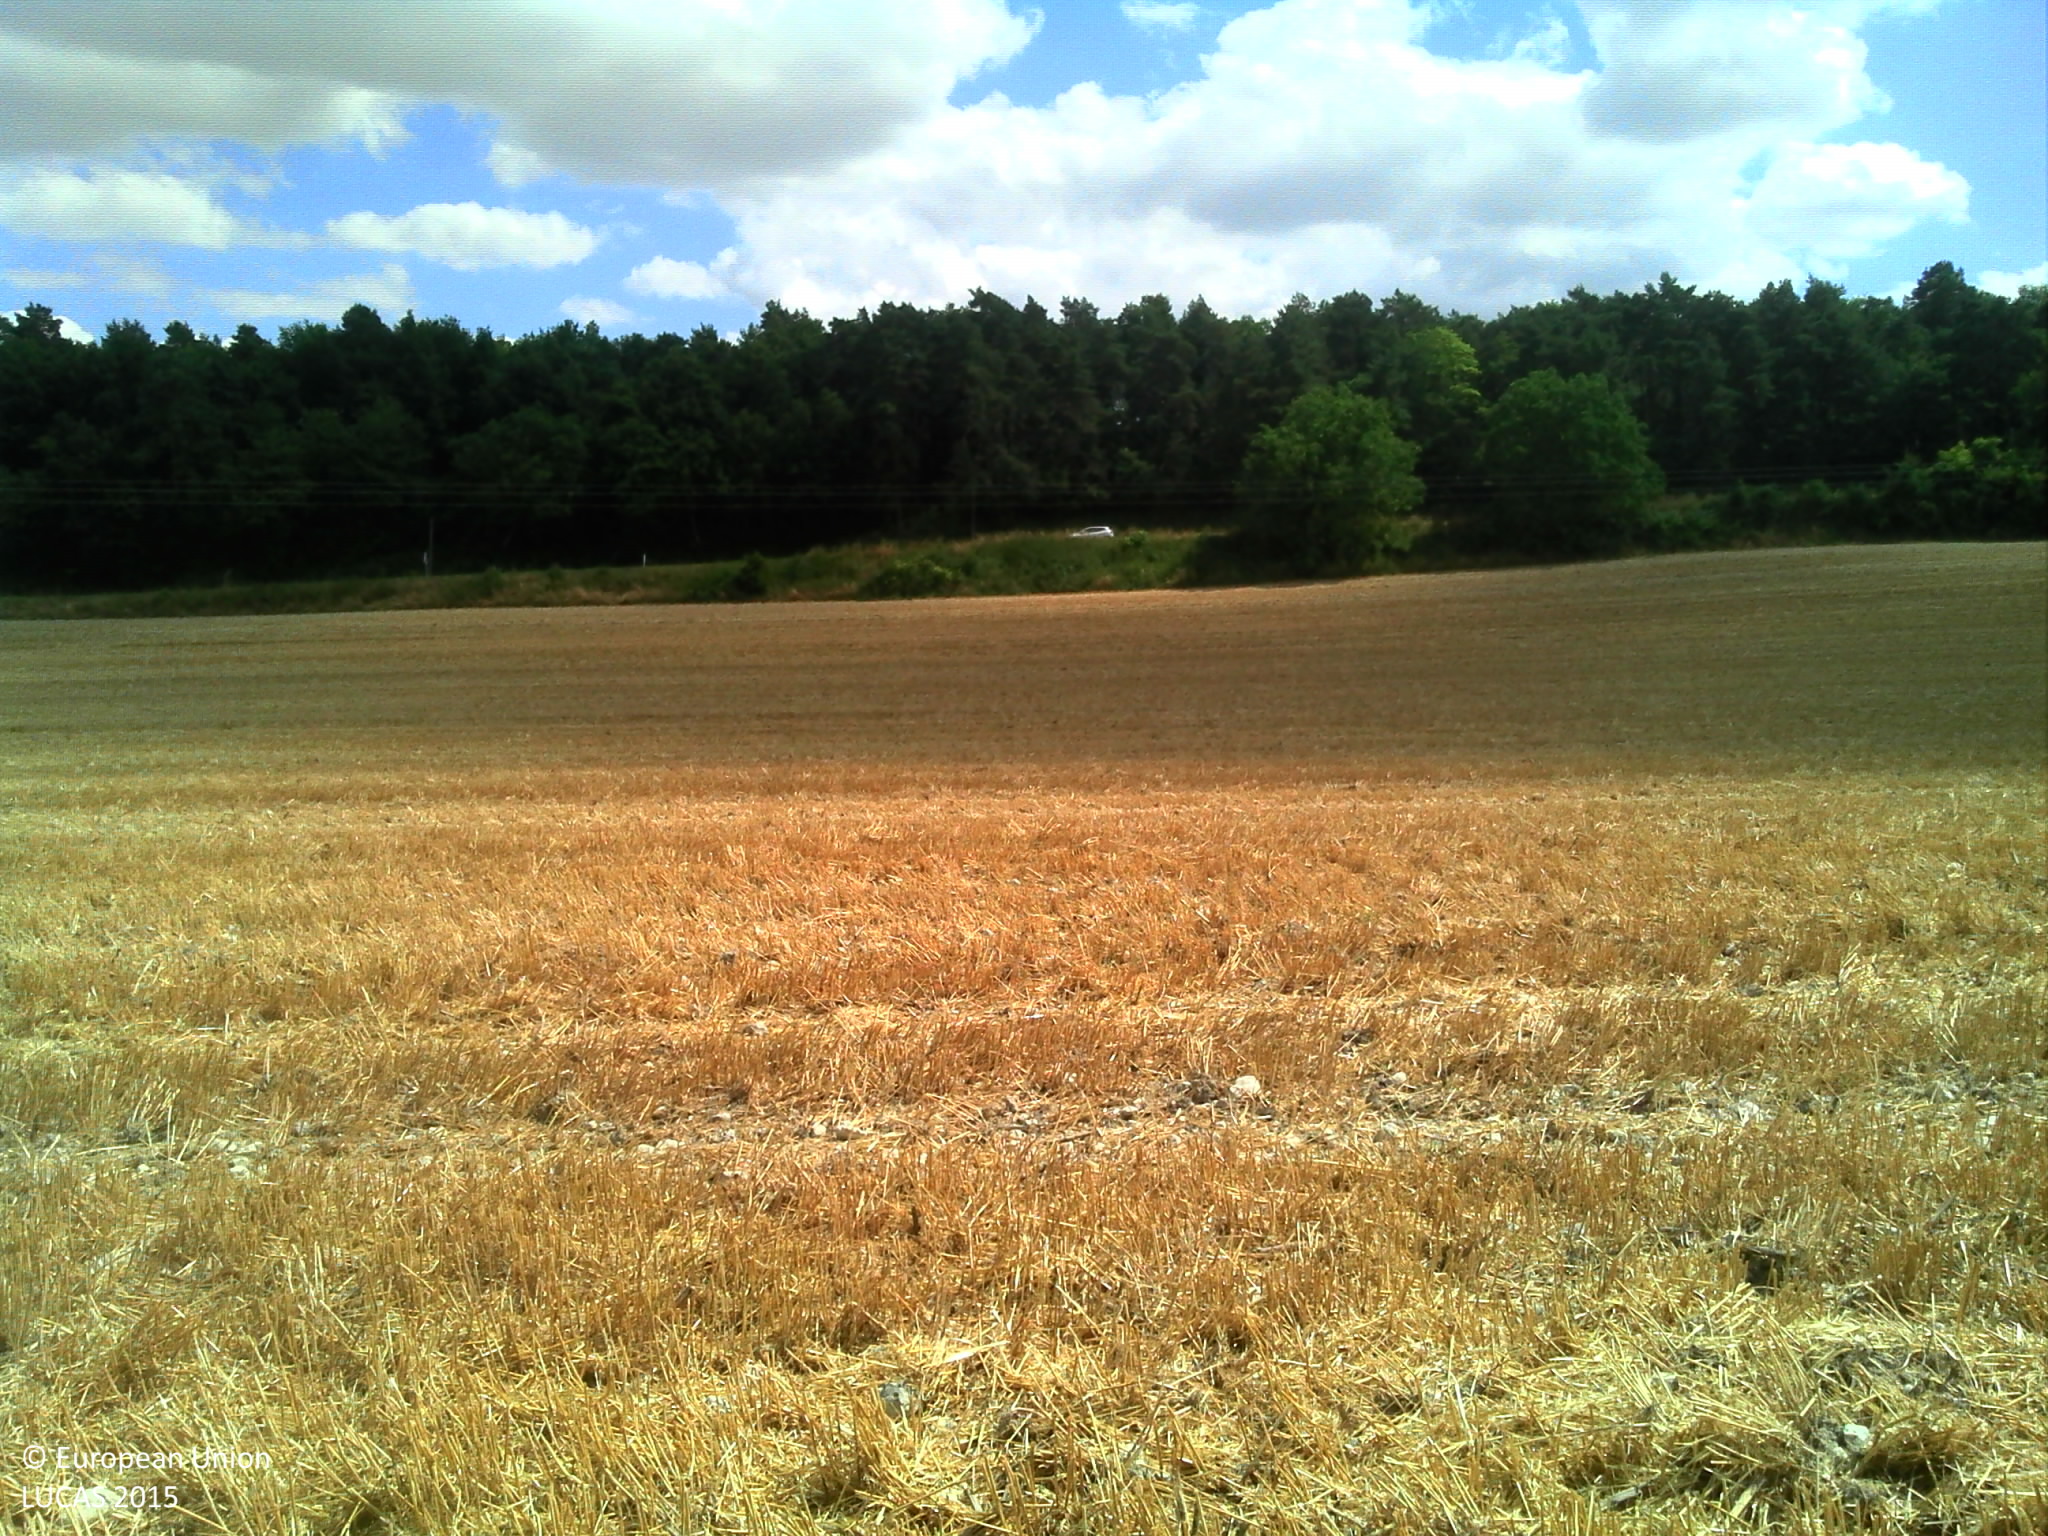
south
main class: Cropland
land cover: Common wheat
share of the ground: > 75 %
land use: Agriculture (excluding fallow land and kitchen gardens)
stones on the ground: > 50 %
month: July
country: FR
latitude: 47.0464
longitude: 0.8616
